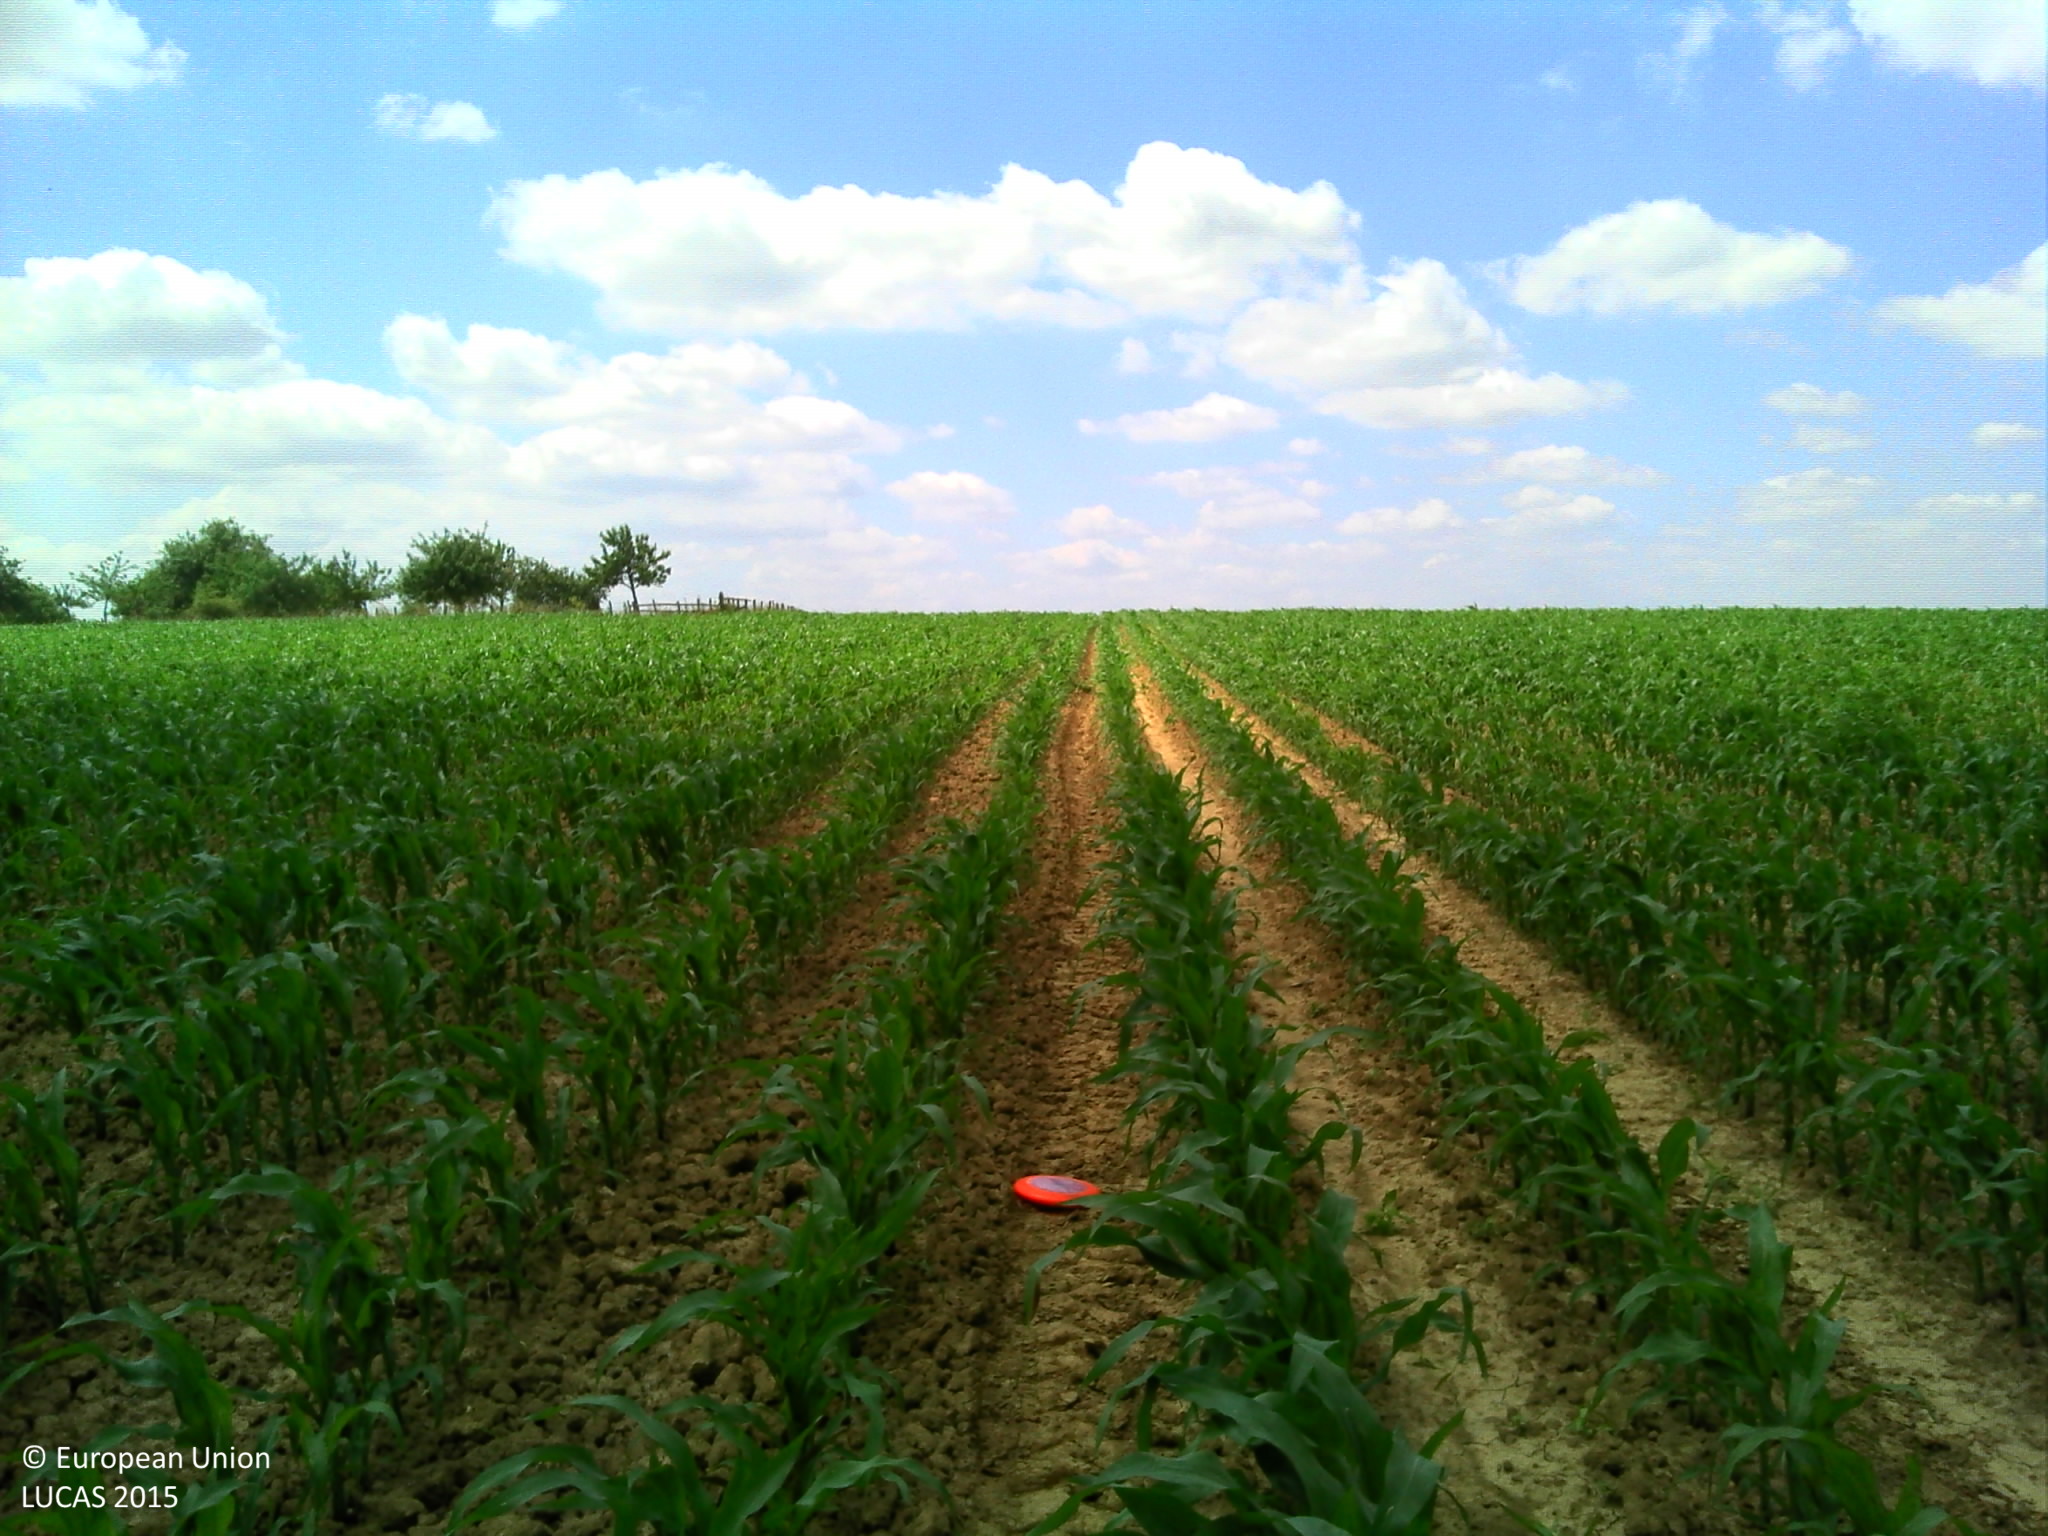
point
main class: Cropland
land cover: Maize
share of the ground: 25 - 50 %
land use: Agriculture (excluding fallow land and kitchen gardens)
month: June
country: FR
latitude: 48.2732
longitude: 0.1774
